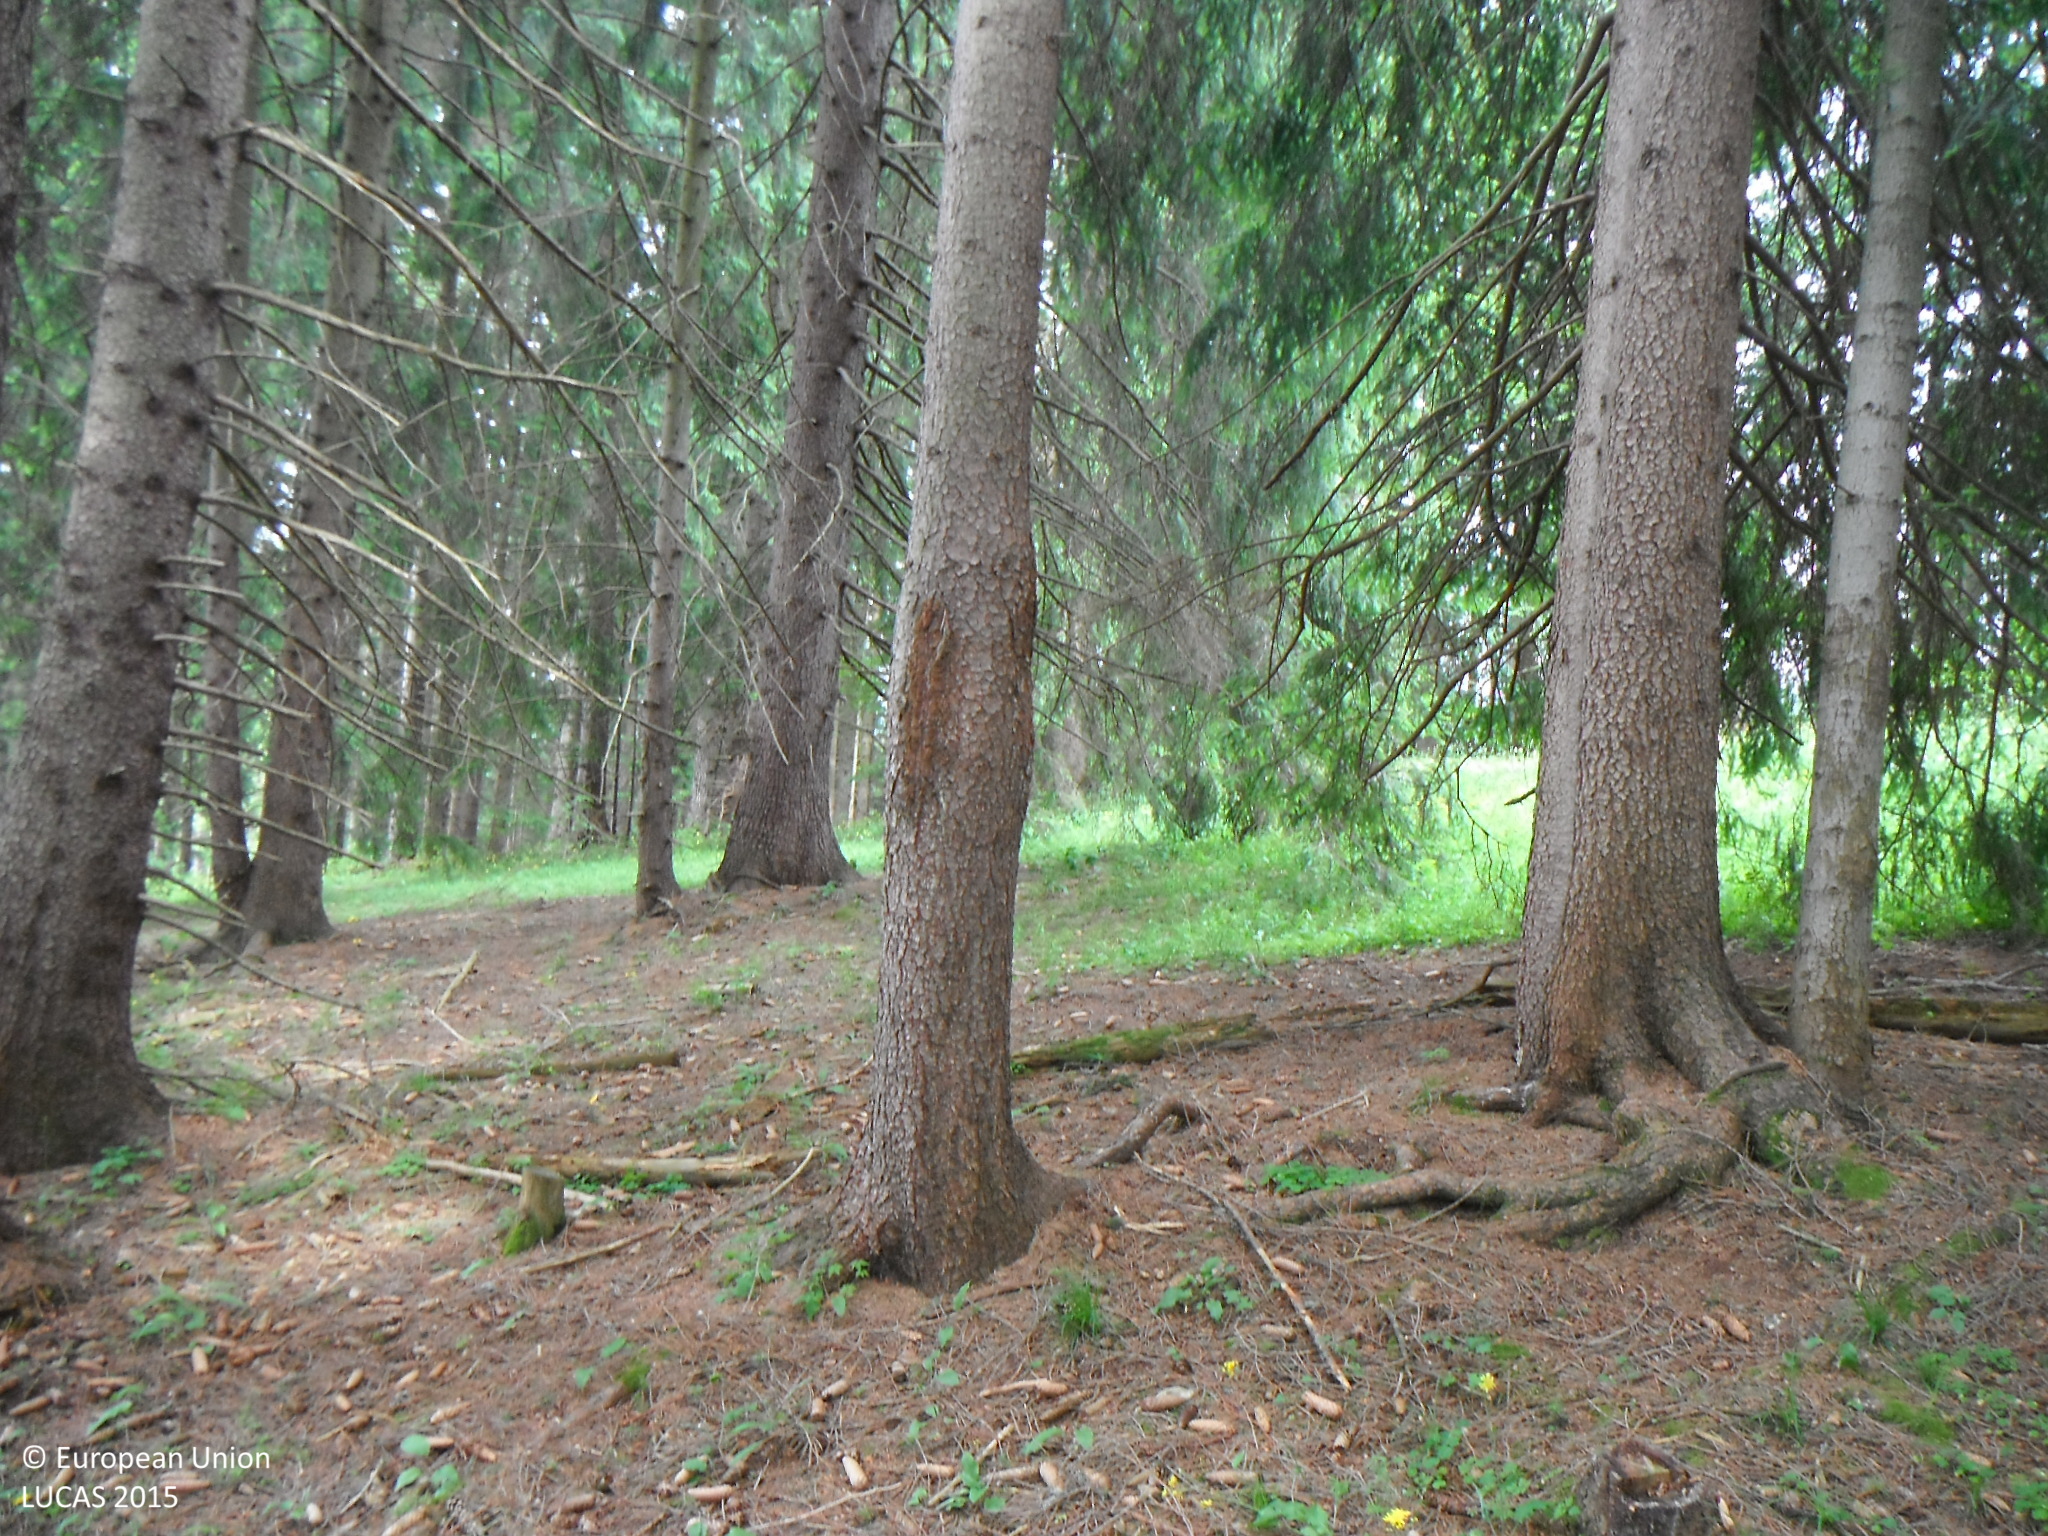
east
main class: Woodland
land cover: Spruce dominated coniferous woodland
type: alpine coniferous forest
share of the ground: > 75 %
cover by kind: coniferous forest trees 75 %, shrubs 10 %, herbaceous plants 10 %, lichens and mosses 5 %
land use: Forestry
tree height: > 5 m
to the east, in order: Spruce dominated coniferous woodland; Tracks; Spruce dominated coniferous woodland; Grass margins; Tracks; Spontaneously vegetated surfaces; Rivers and streams; Spruce dominated coniferous woodland
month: June
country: SK
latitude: 49.0305
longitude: 19.4491
